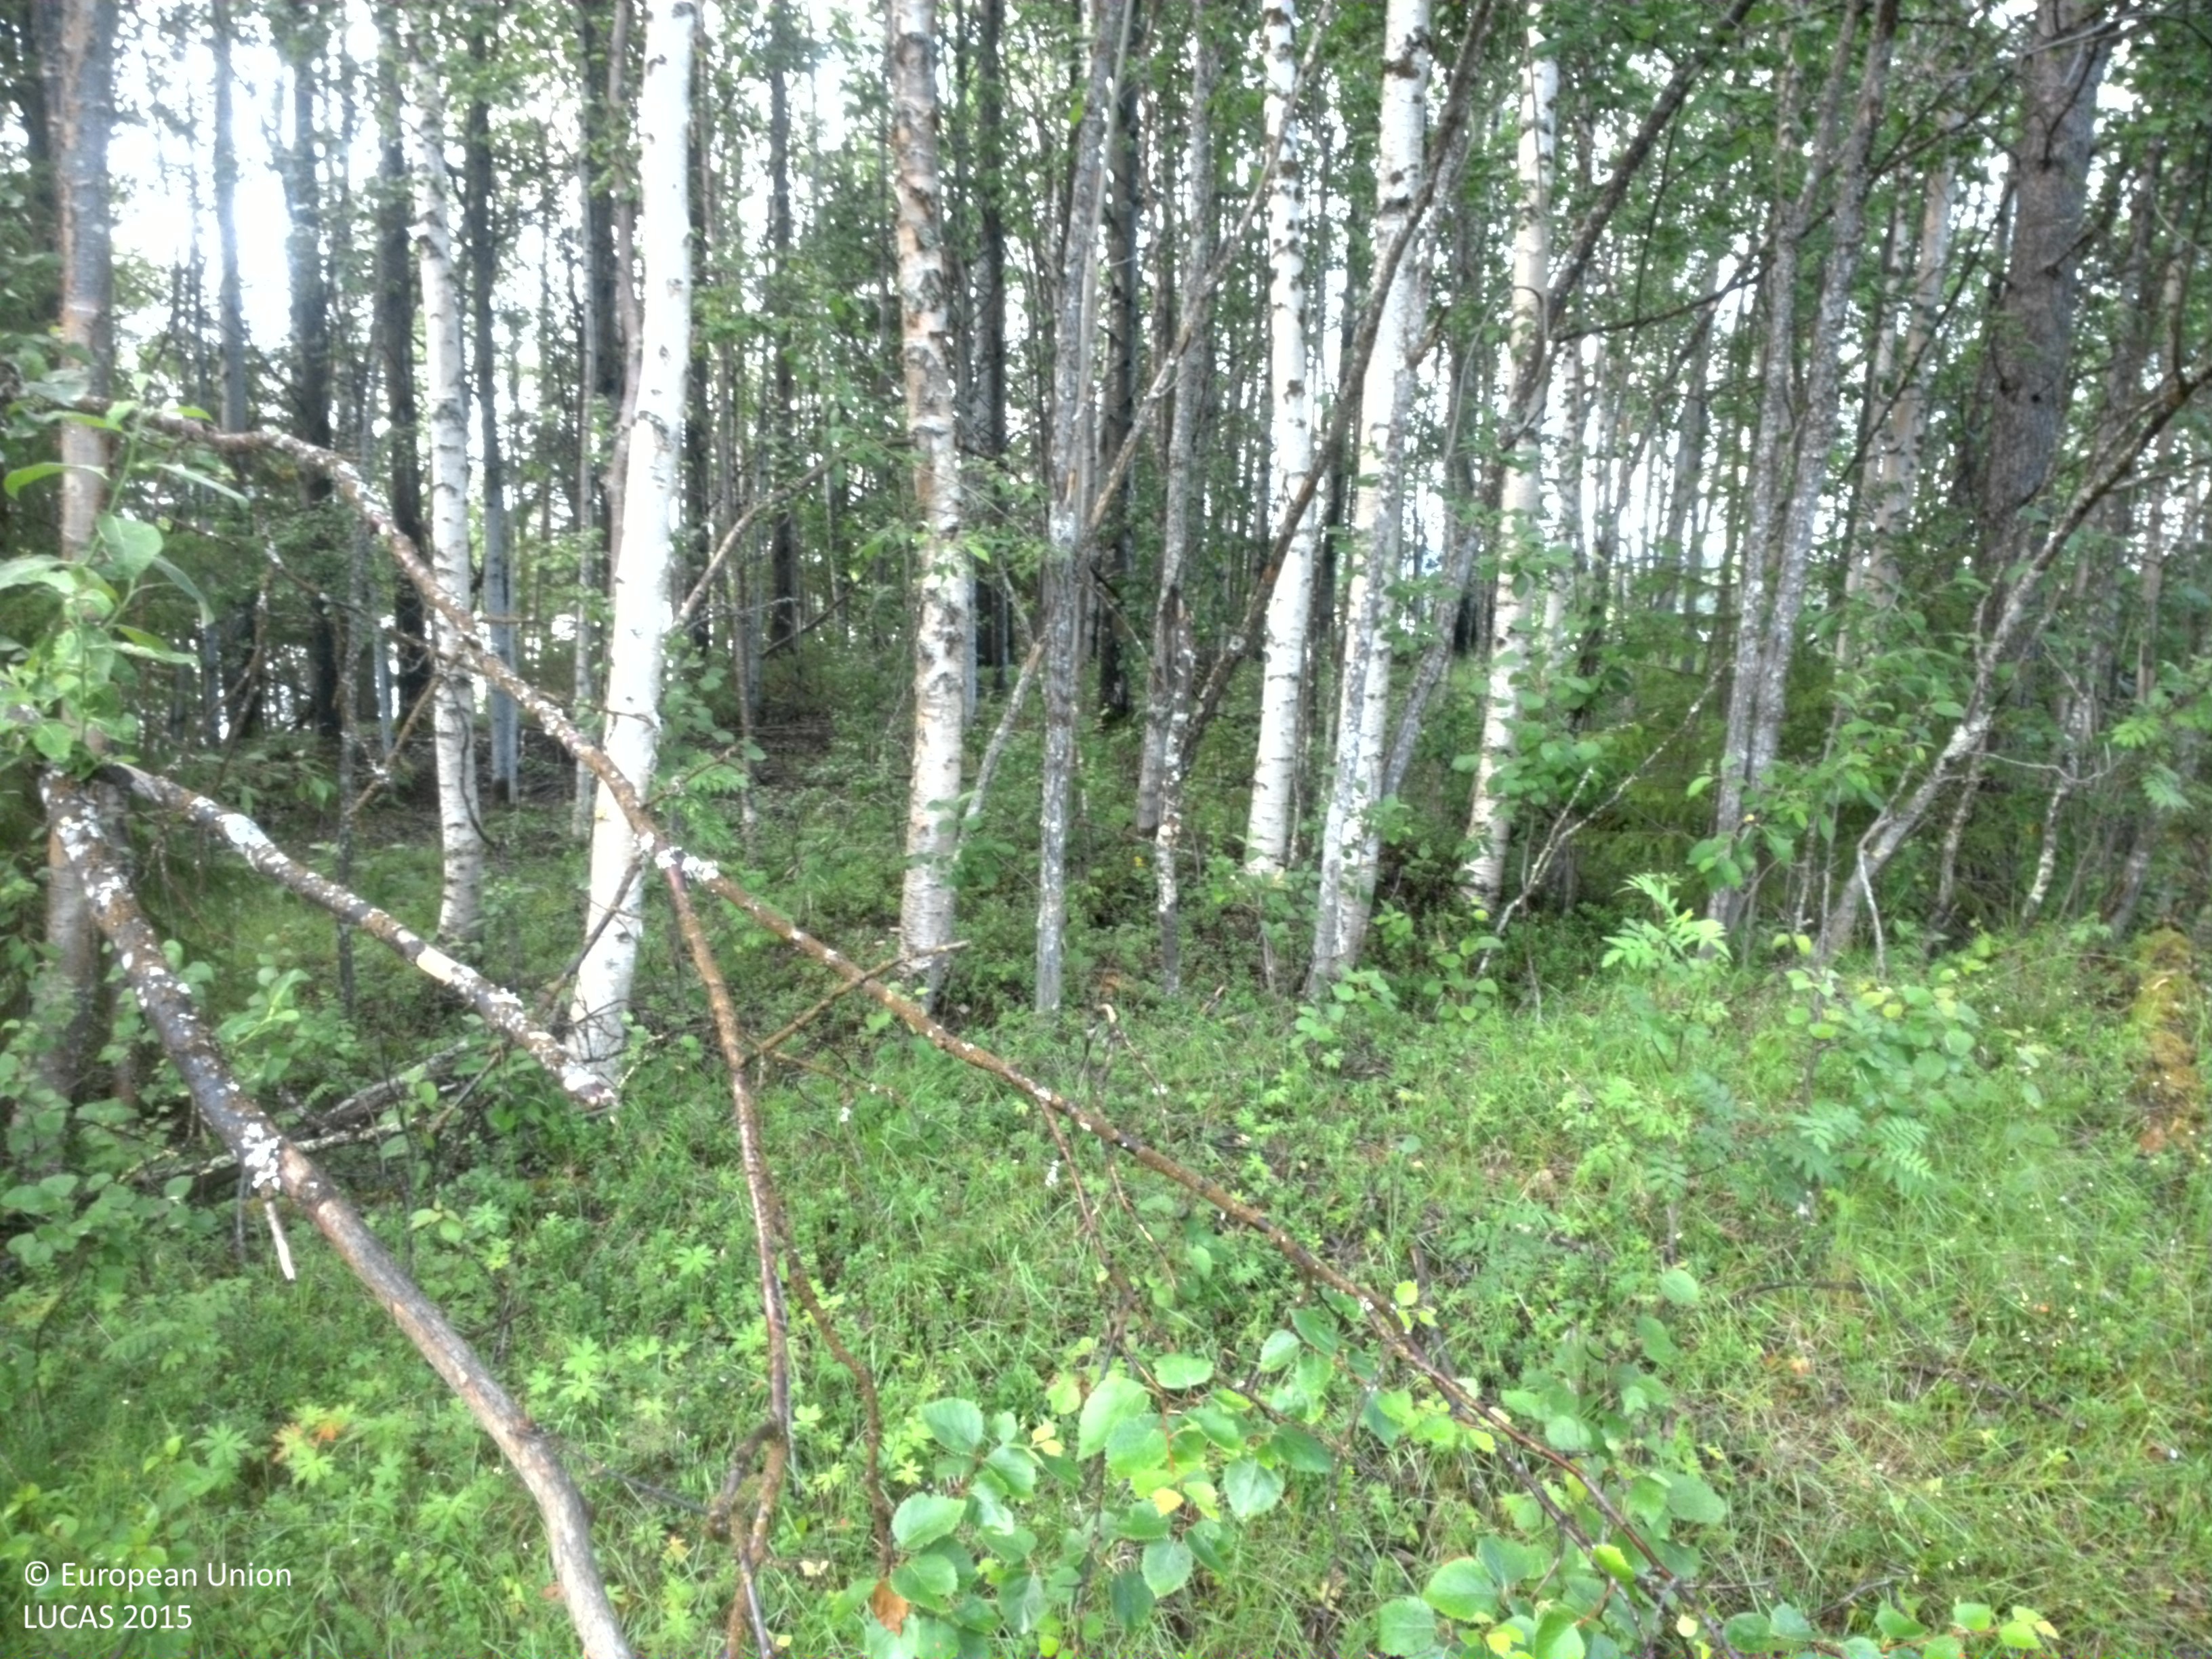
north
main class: Grassland
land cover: Grassland with sparse tree/shrub cover
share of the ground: > 75 %
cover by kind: herbaceous plants 85 %, shrubs 10 %, broadleaved forest trees 5 %
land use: Abandoned areas
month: July
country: SE
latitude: 66.1381
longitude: 20.3938
